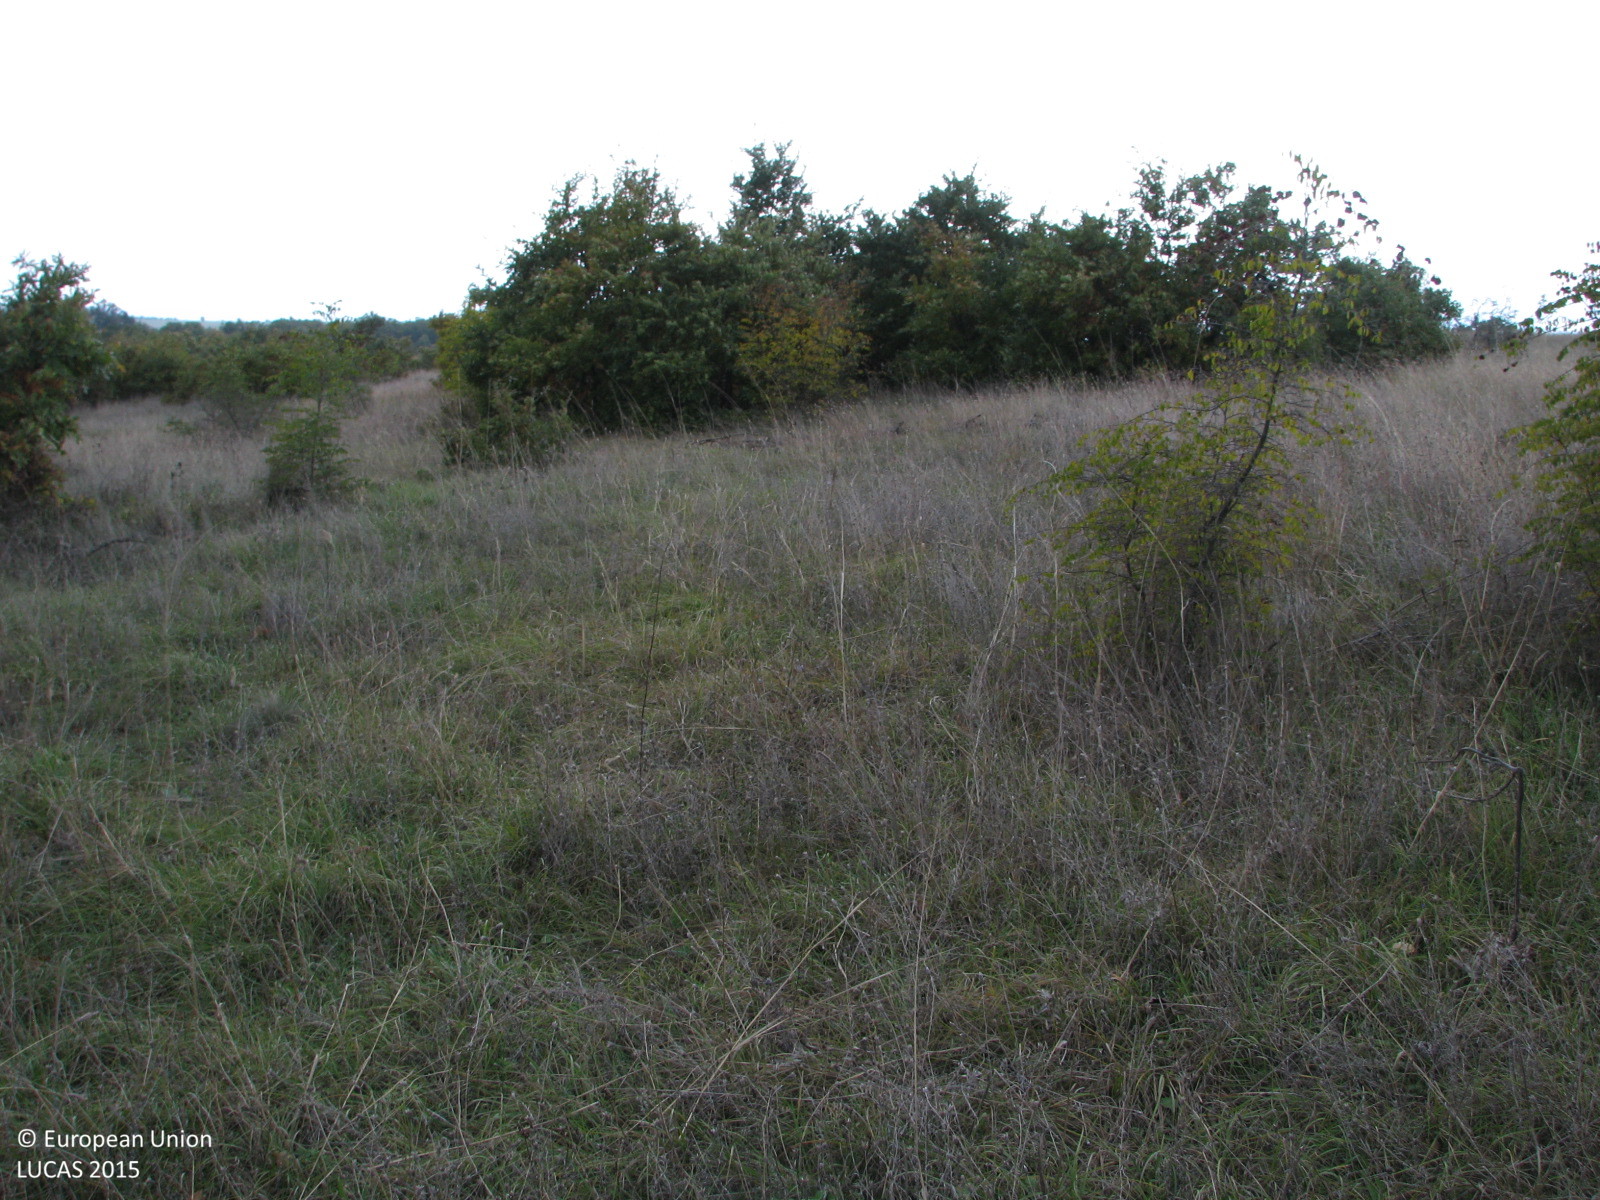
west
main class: Grassland
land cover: Grassland with sparse tree/shrub cover
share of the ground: > 75 %
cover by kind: herbaceous plants 85 %, shrubs 10 %, broadleaved forest trees 5 %
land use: Semi-natural and natural areas not in use
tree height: < 5 m
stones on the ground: < 10 %
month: October
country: BG
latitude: 41.9884
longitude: 26.6129
